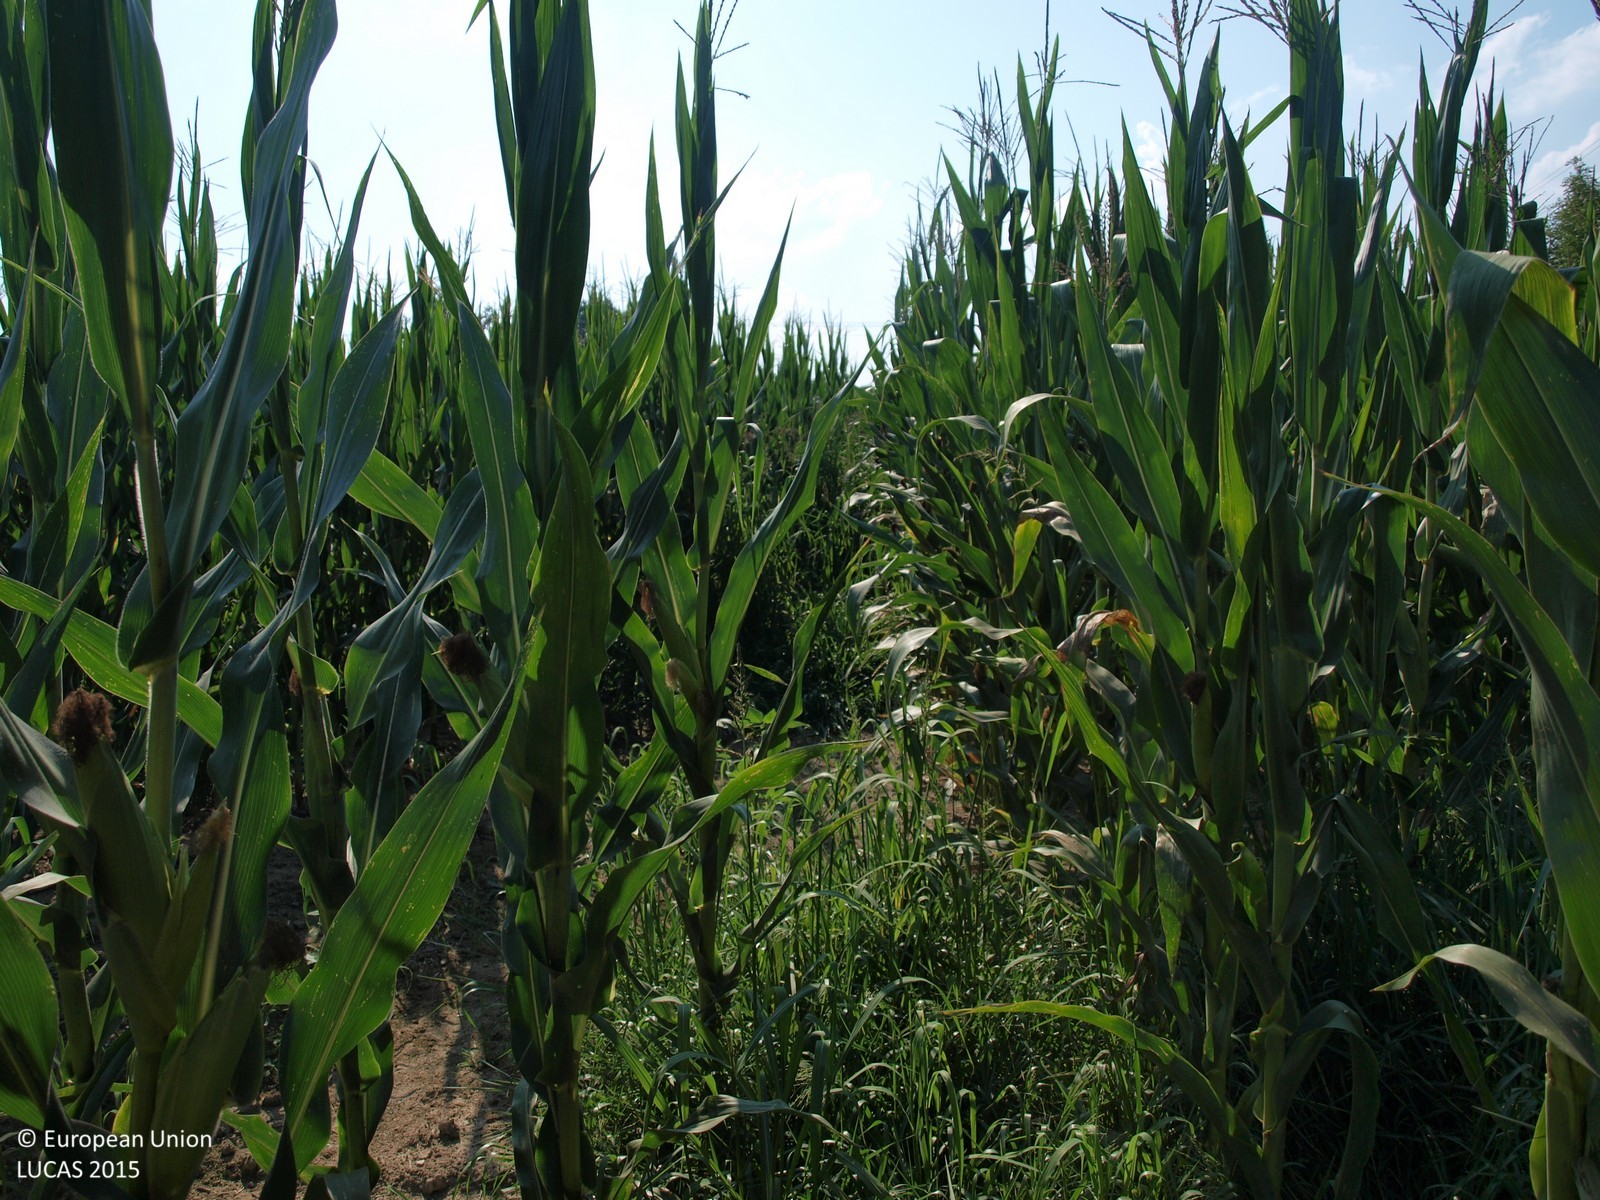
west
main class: Cropland
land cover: Maize
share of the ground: > 75 %
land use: Agriculture (excluding fallow land and kitchen gardens)
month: August
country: HR
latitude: 45.8641
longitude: 16.5042
